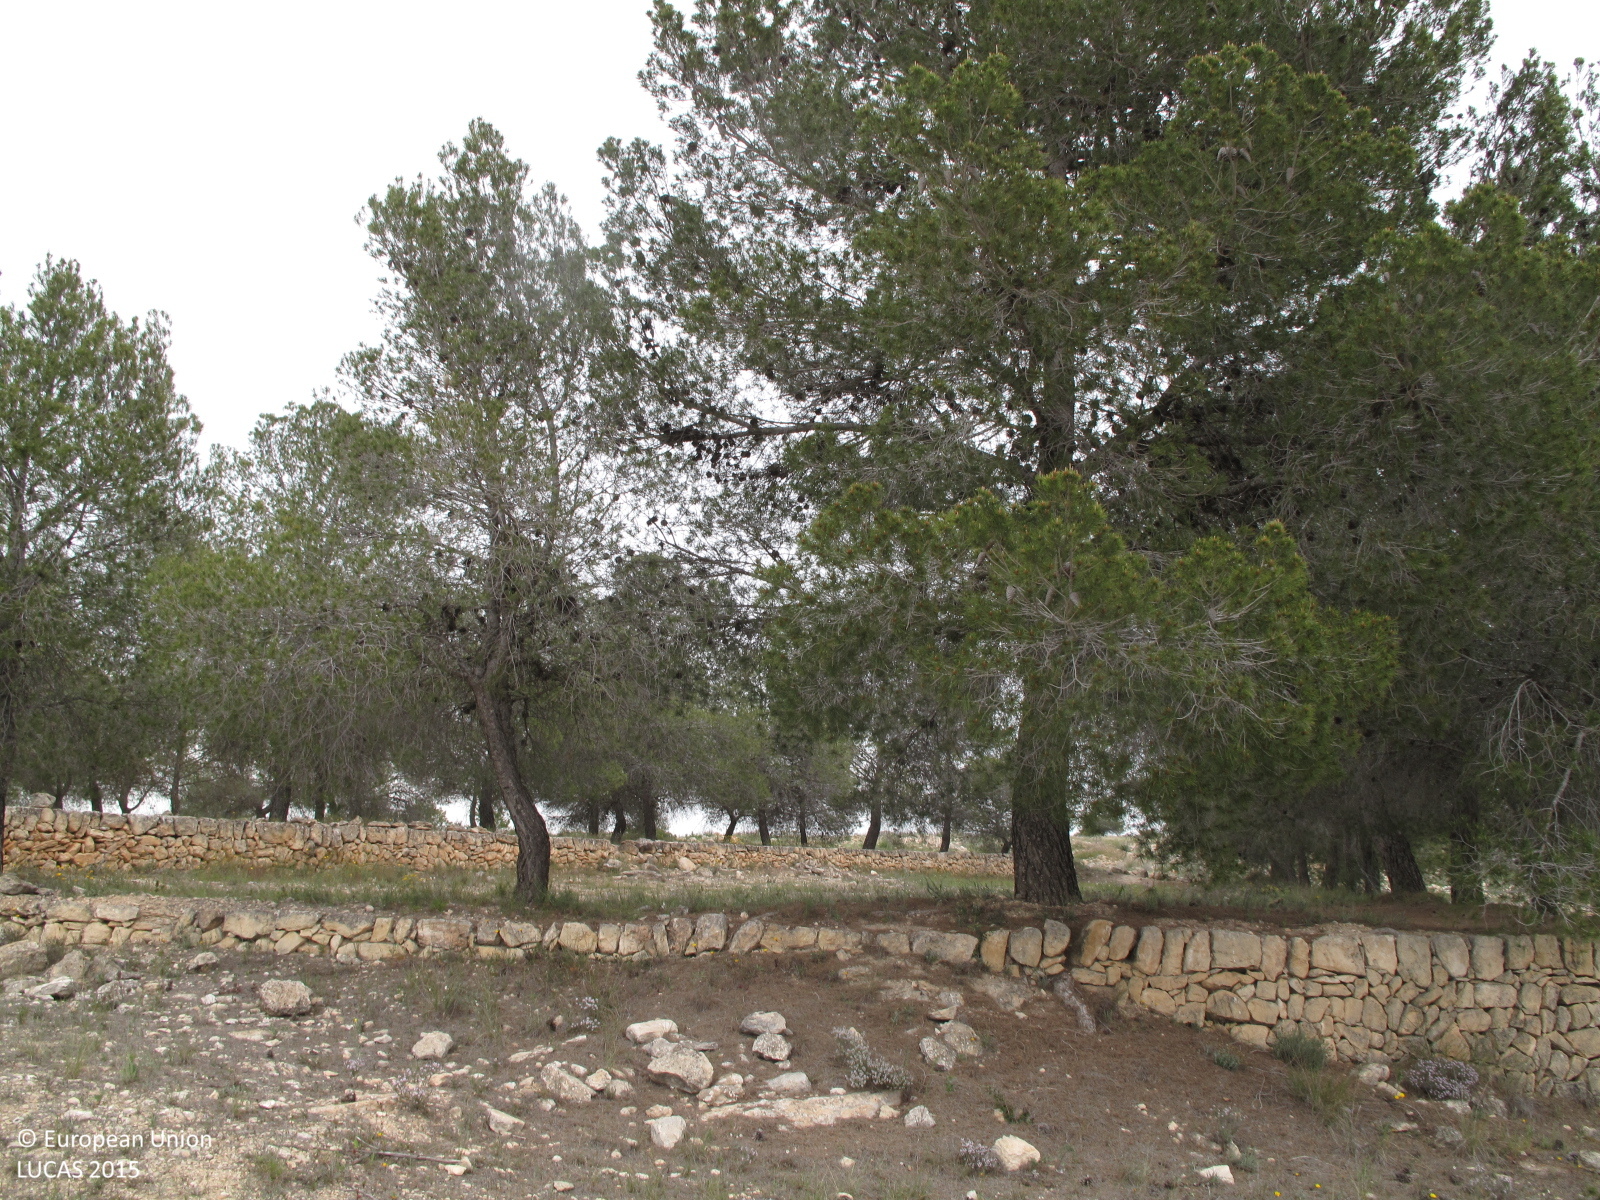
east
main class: Cropland
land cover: Nuts trees
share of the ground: < 10 %
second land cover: Spontaneously vegetated surfaces
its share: > 75 %
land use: Agriculture (excluding fallow land and kitchen gardens)
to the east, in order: Nuts trees; Spontaneously vegetated surfaces; Dry stone walls; Pine dominated coniferous woodland; Tracks; Dry stone walls; Pine dominated coniferous woodland; Paved roads, cycling and walking lanes; Shrubland without tree cover; Tracks; Grassland with sparse tree/shrub cover; Dry stone walls; Grassland with sparse tree/shrub cover
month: April
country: ES
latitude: 38.4344
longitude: -0.9057
